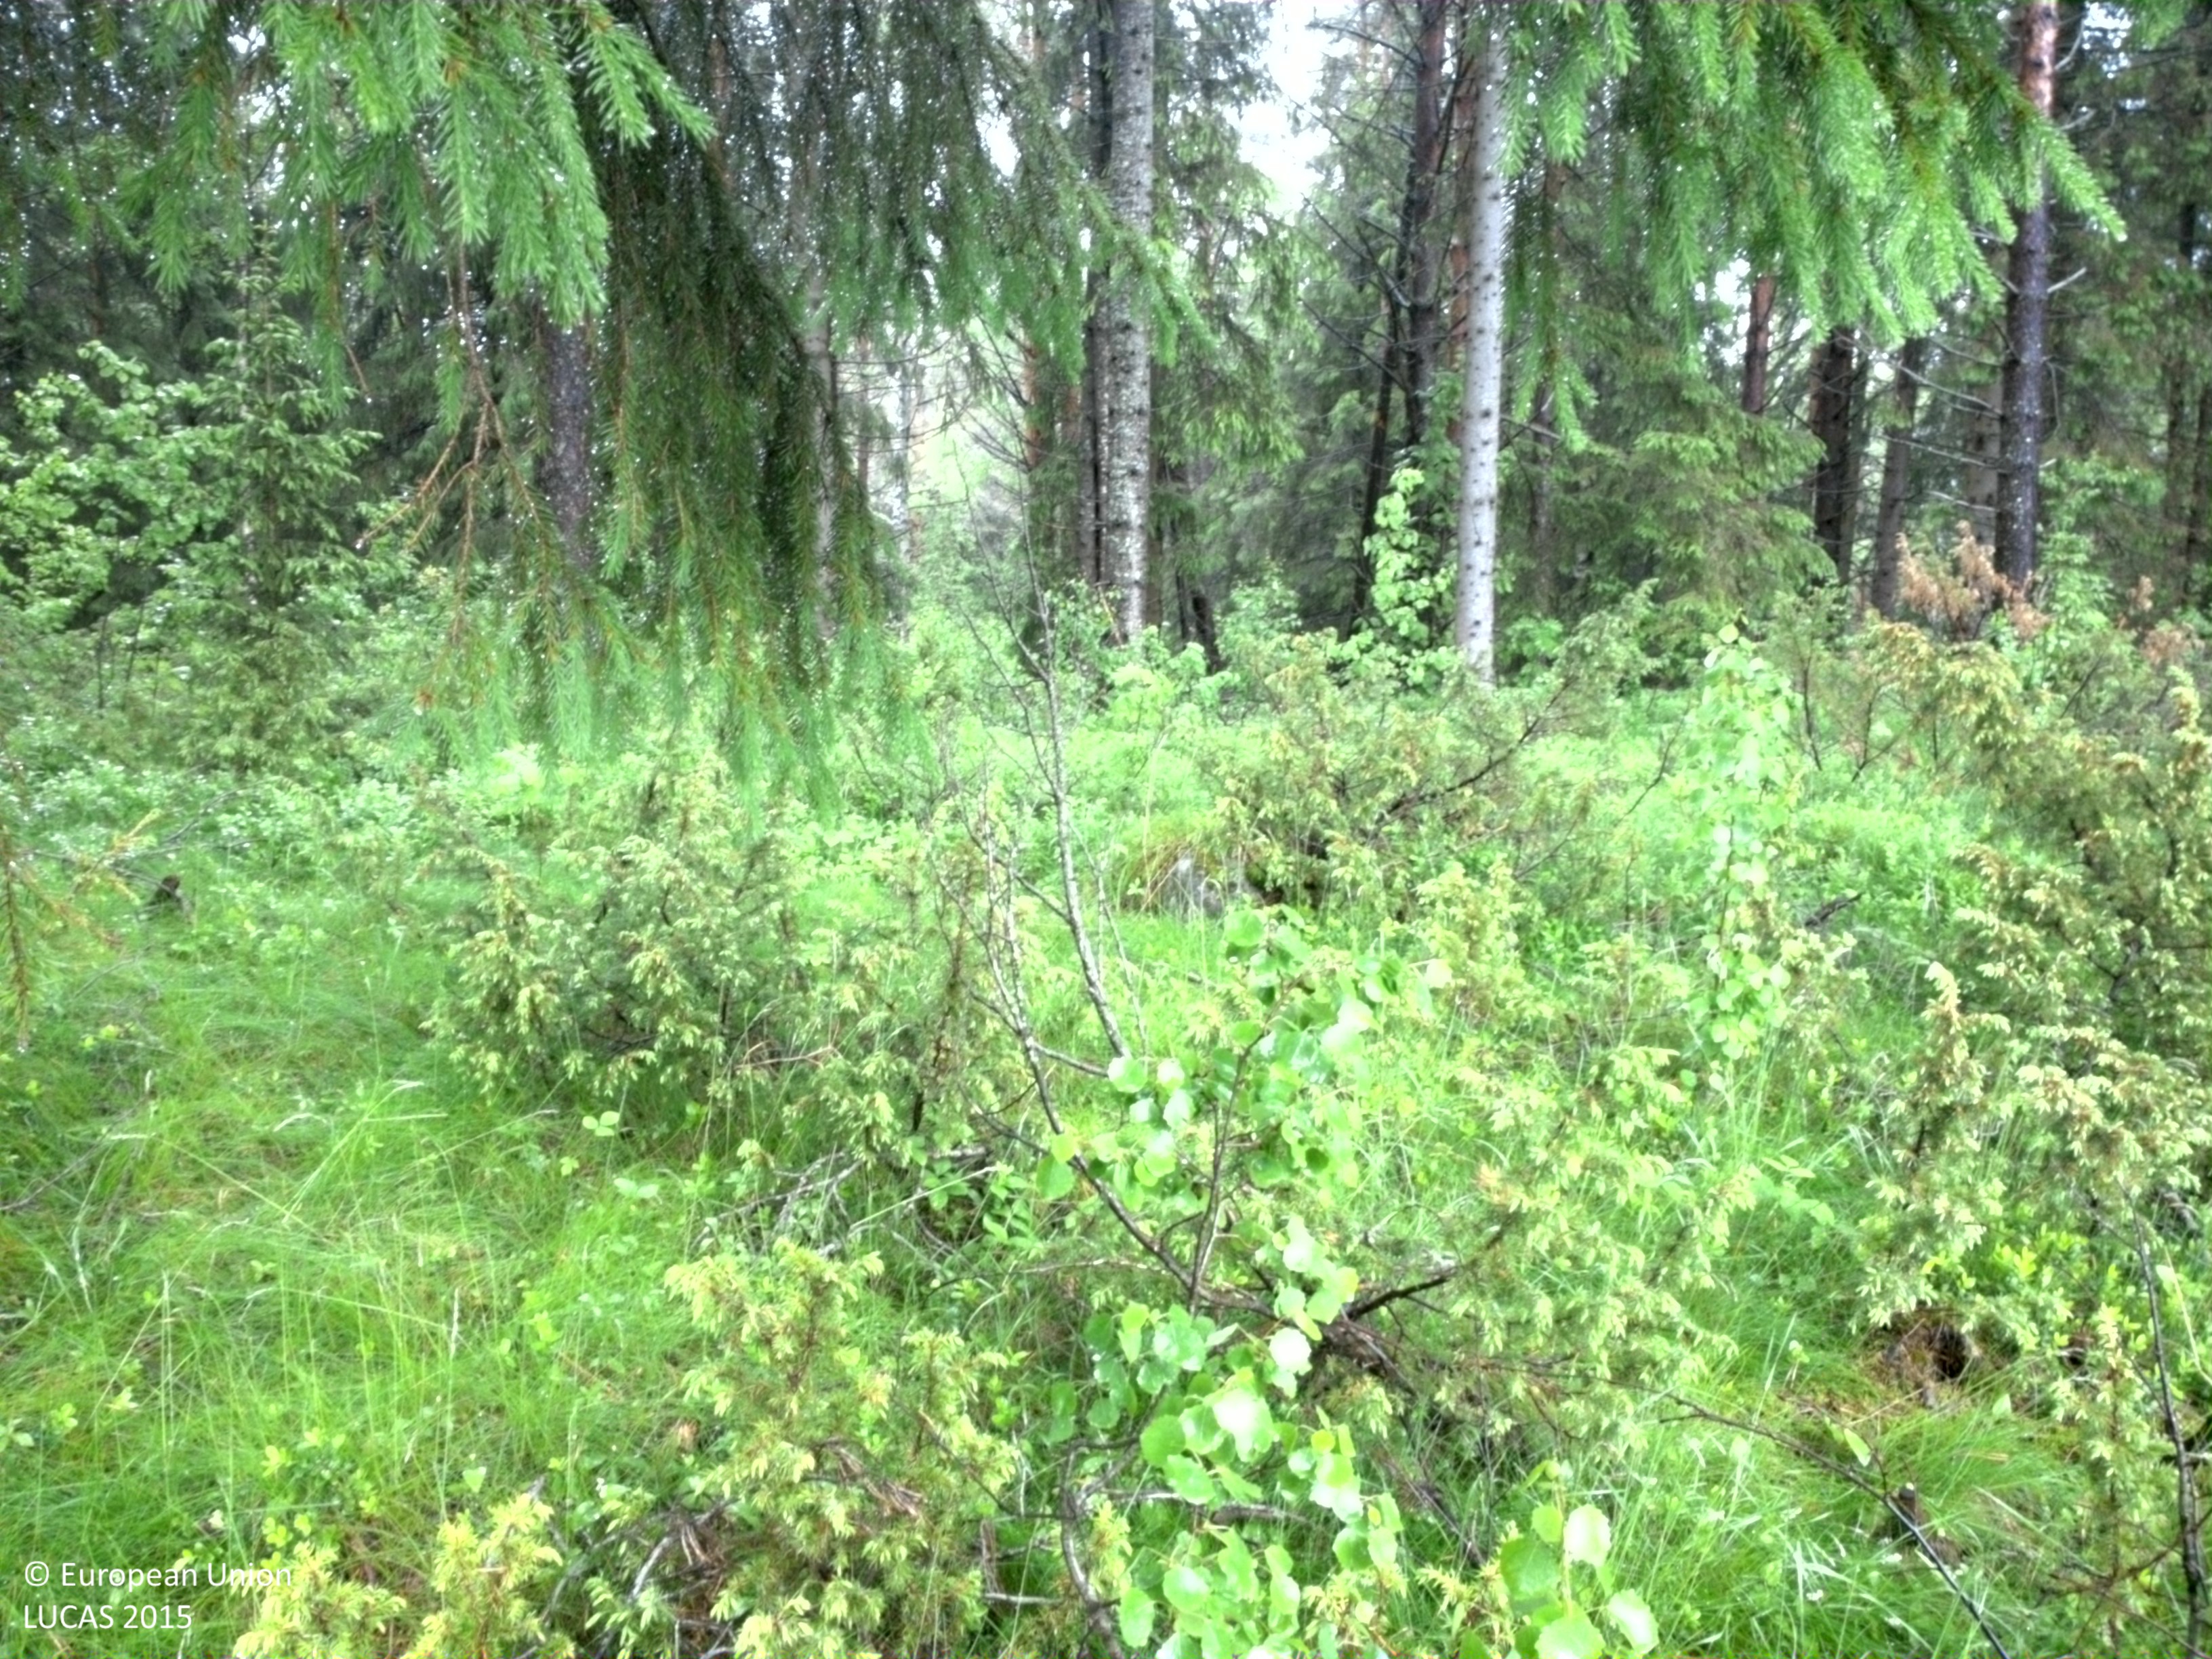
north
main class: Woodland
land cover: Spruce dominated coniferous woodland
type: boreal forest
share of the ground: 50 - 75 %
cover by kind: coniferous forest trees 65 %, shrubs 25 %, broadleaved forest trees 5 %, herbaceous plants 5 %
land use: Forestry
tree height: > 5 m
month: June
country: SE
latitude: 64.3361
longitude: 20.8460
